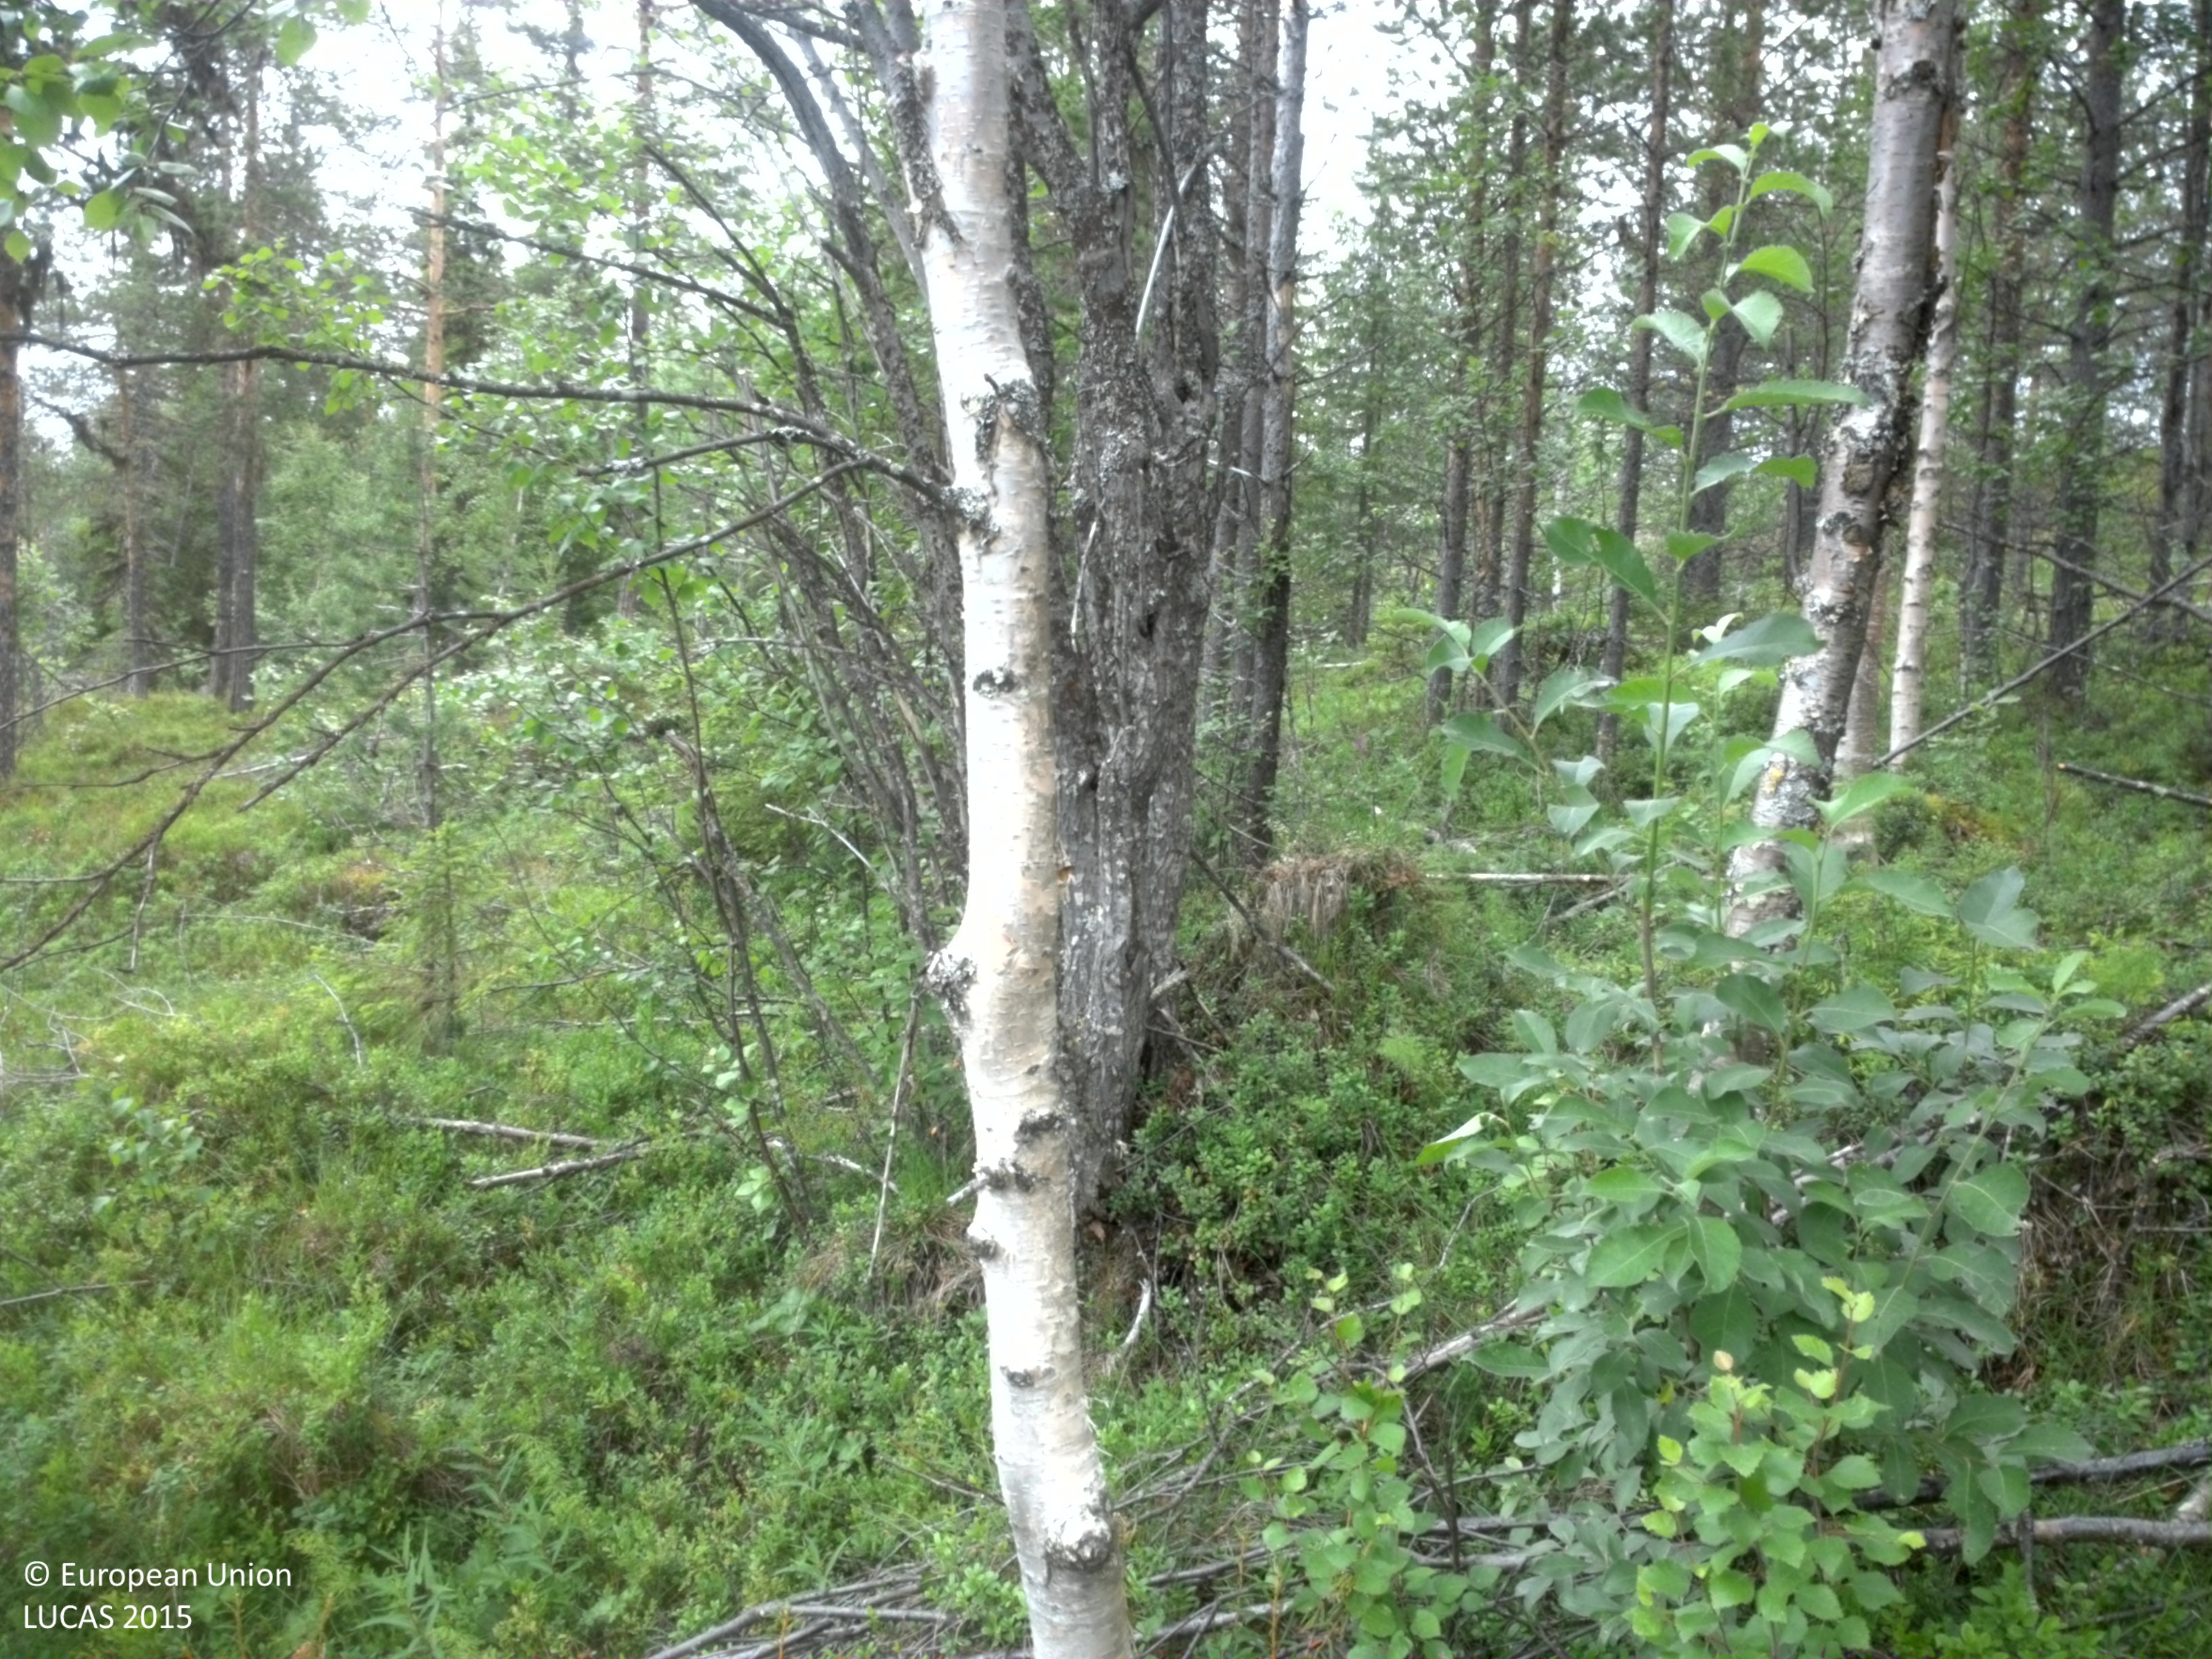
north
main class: Woodland
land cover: Pine dominated mixed woodland
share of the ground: 25 - 50 %
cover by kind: shrubs 50 %, broadleaved forest trees 30 %, coniferous forest trees 20 %
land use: Forestry
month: August
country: SE
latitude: 66.1875
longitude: 19.8786
